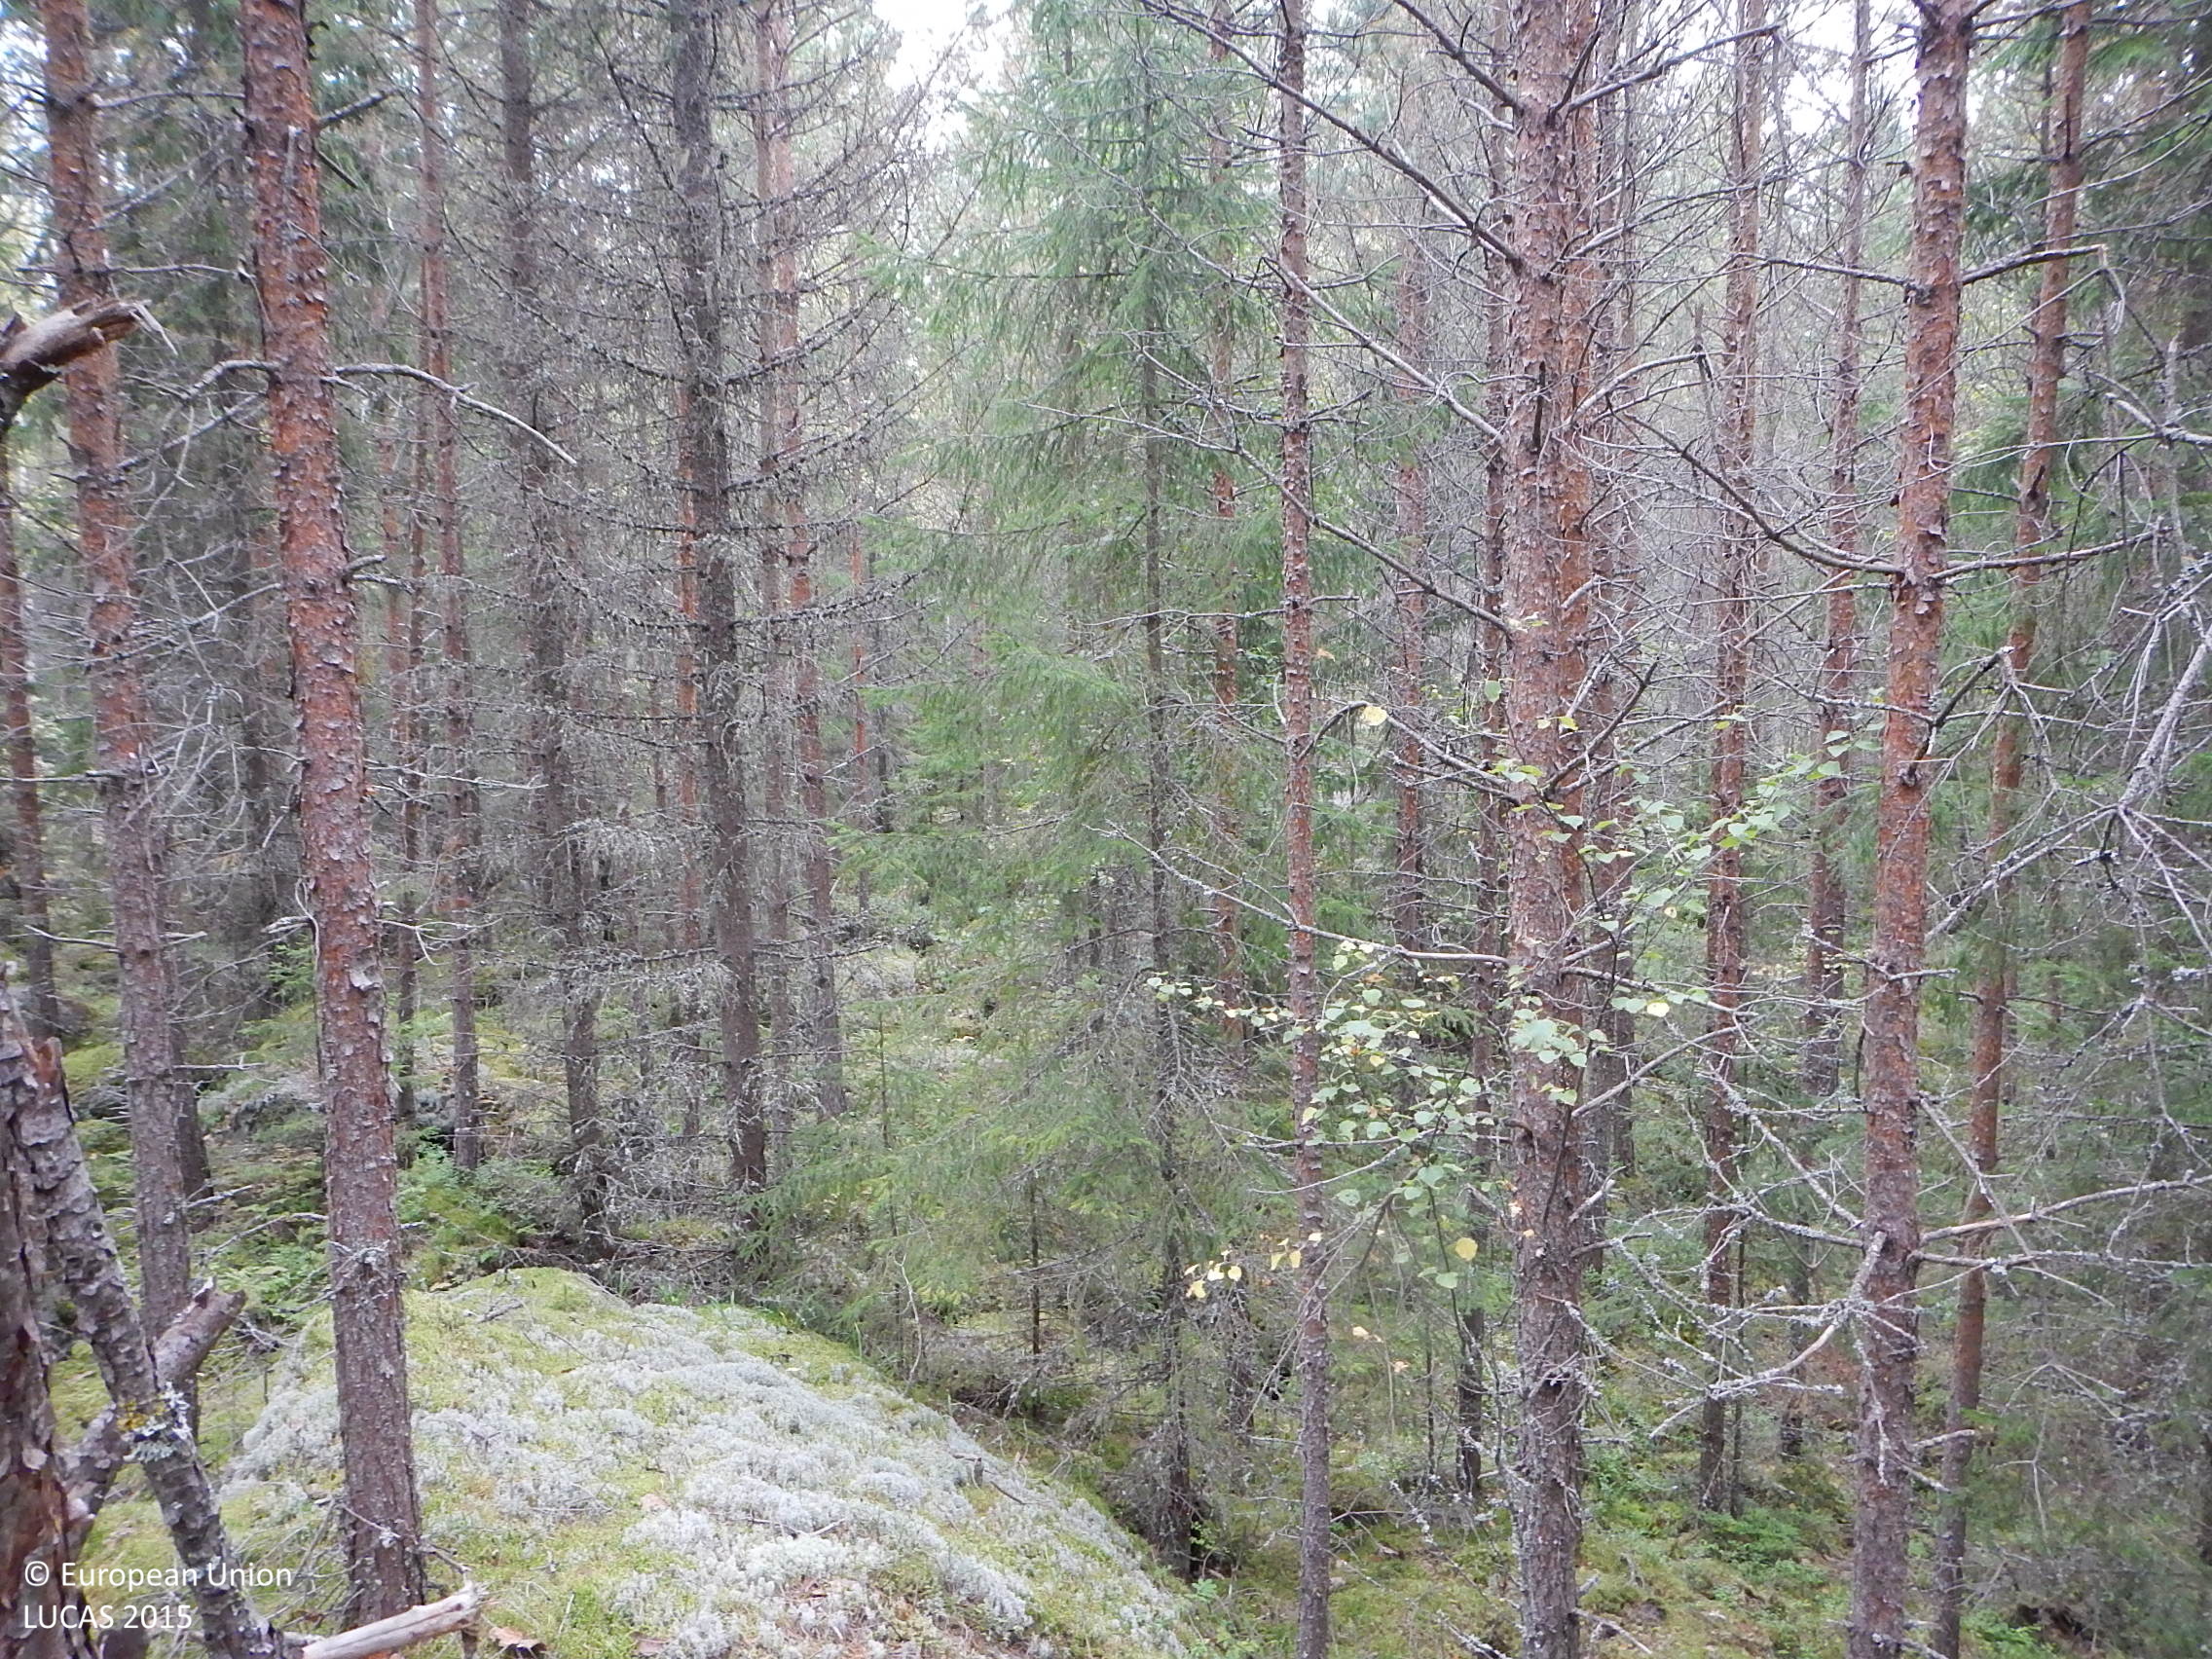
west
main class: Woodland
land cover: Pine dominated coniferous woodland
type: boreal forest
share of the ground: > 75 %
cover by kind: coniferous forest trees 80 %, lichens and mosses 15 %, shrubs 5 %
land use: Forestry
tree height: > 5 m
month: September
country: FI
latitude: 61.5811
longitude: 22.0169
